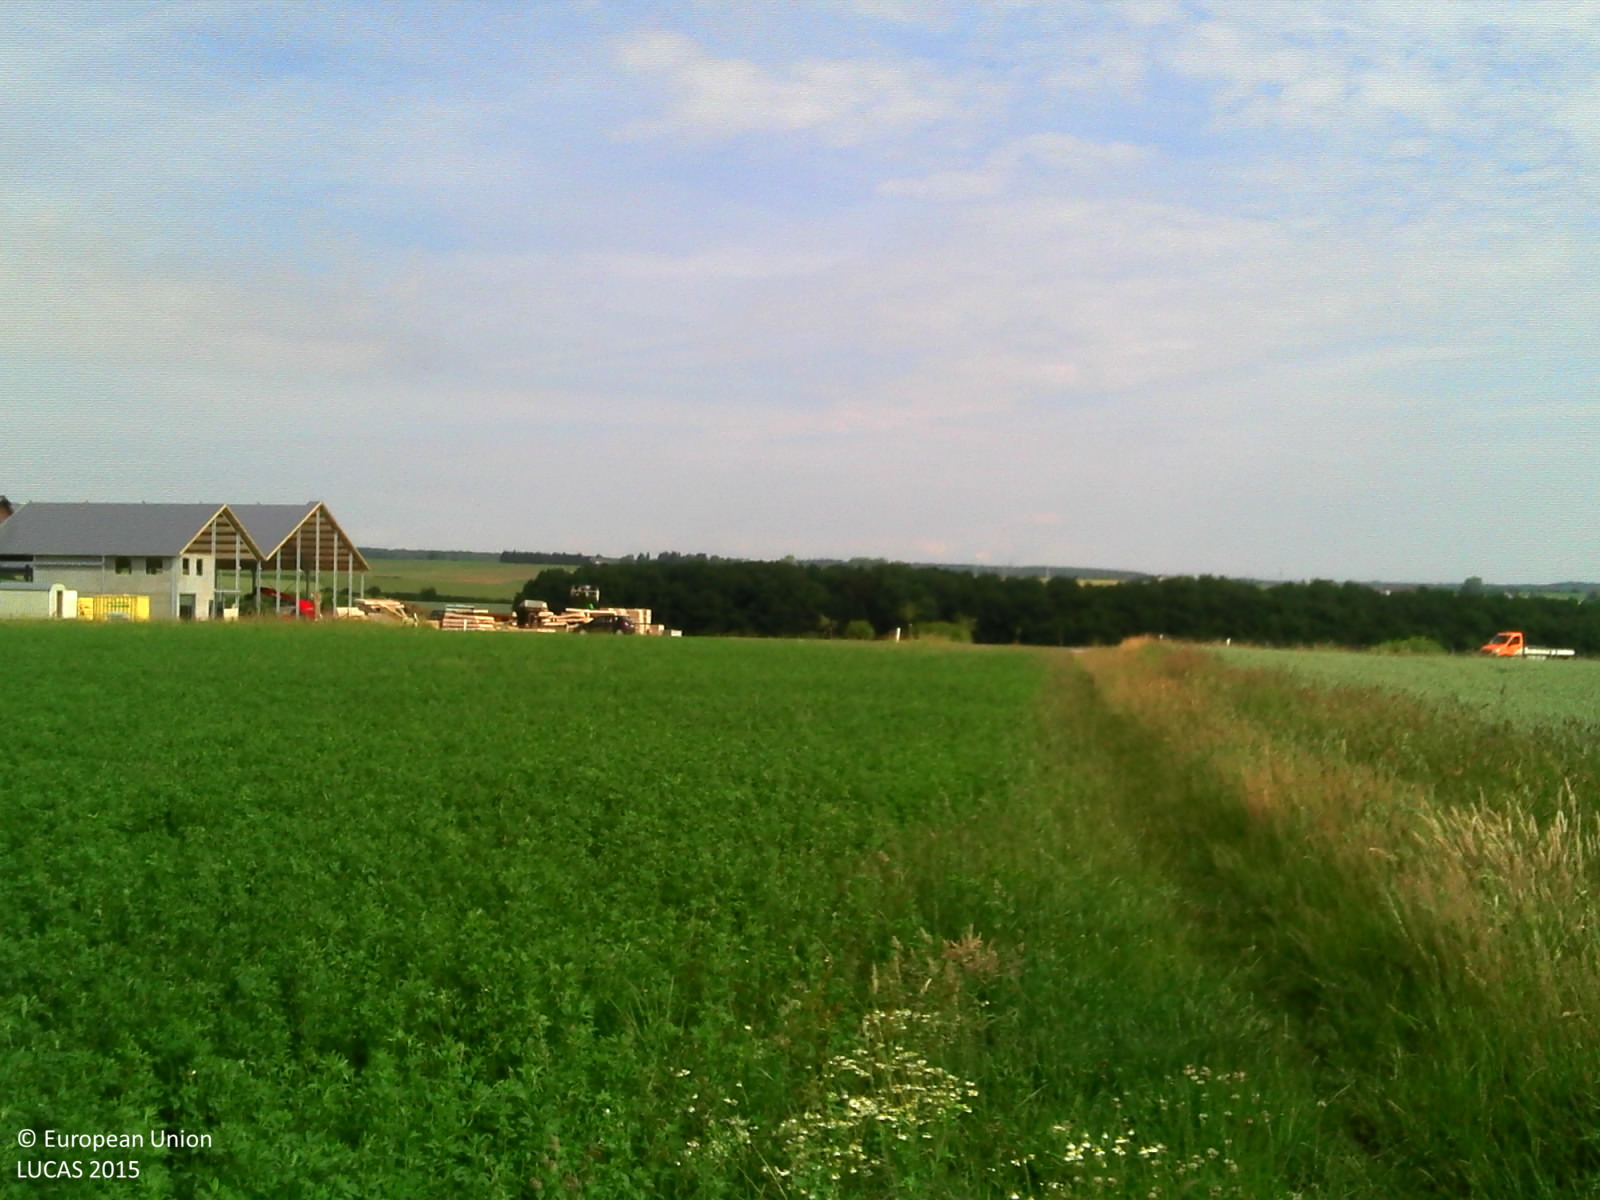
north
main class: Cropland
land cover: Common wheat
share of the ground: > 75 %
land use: Agriculture (excluding fallow land and kitchen gardens)
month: June
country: LU
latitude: 49.7810
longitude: 6.2637
